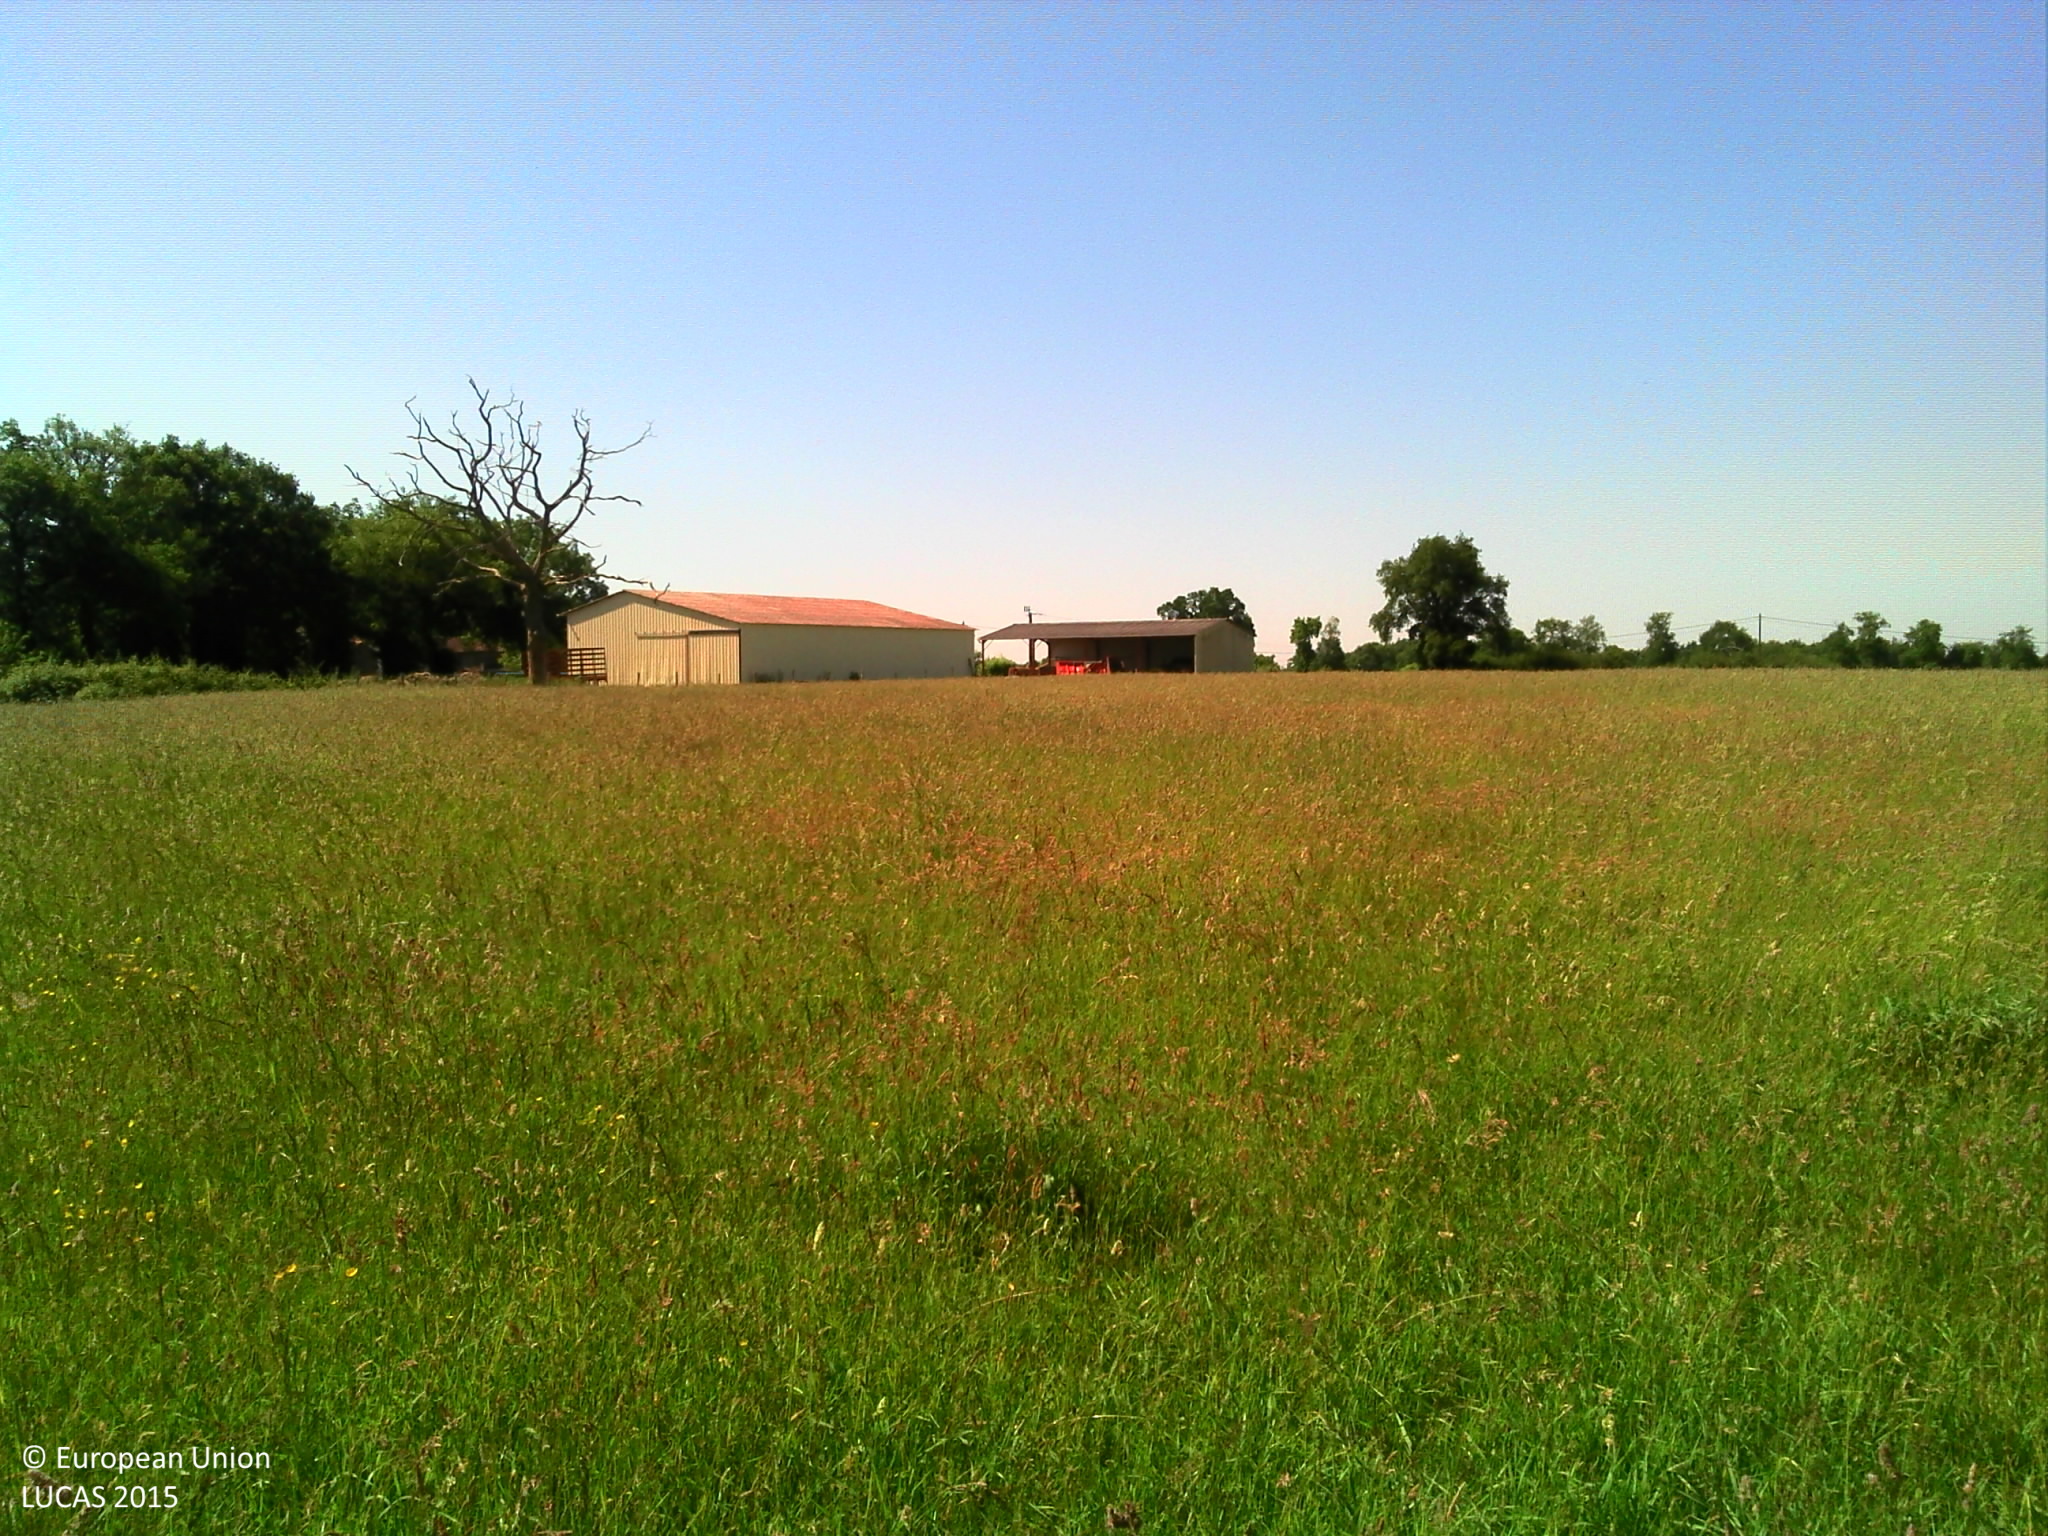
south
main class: Grassland
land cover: Grassland without tree/shrub cover
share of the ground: > 75 %
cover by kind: herbaceous plants 100 %
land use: Agriculture (excluding fallow land and kitchen gardens)
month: June
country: FR
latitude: 46.0466
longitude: 0.6160
